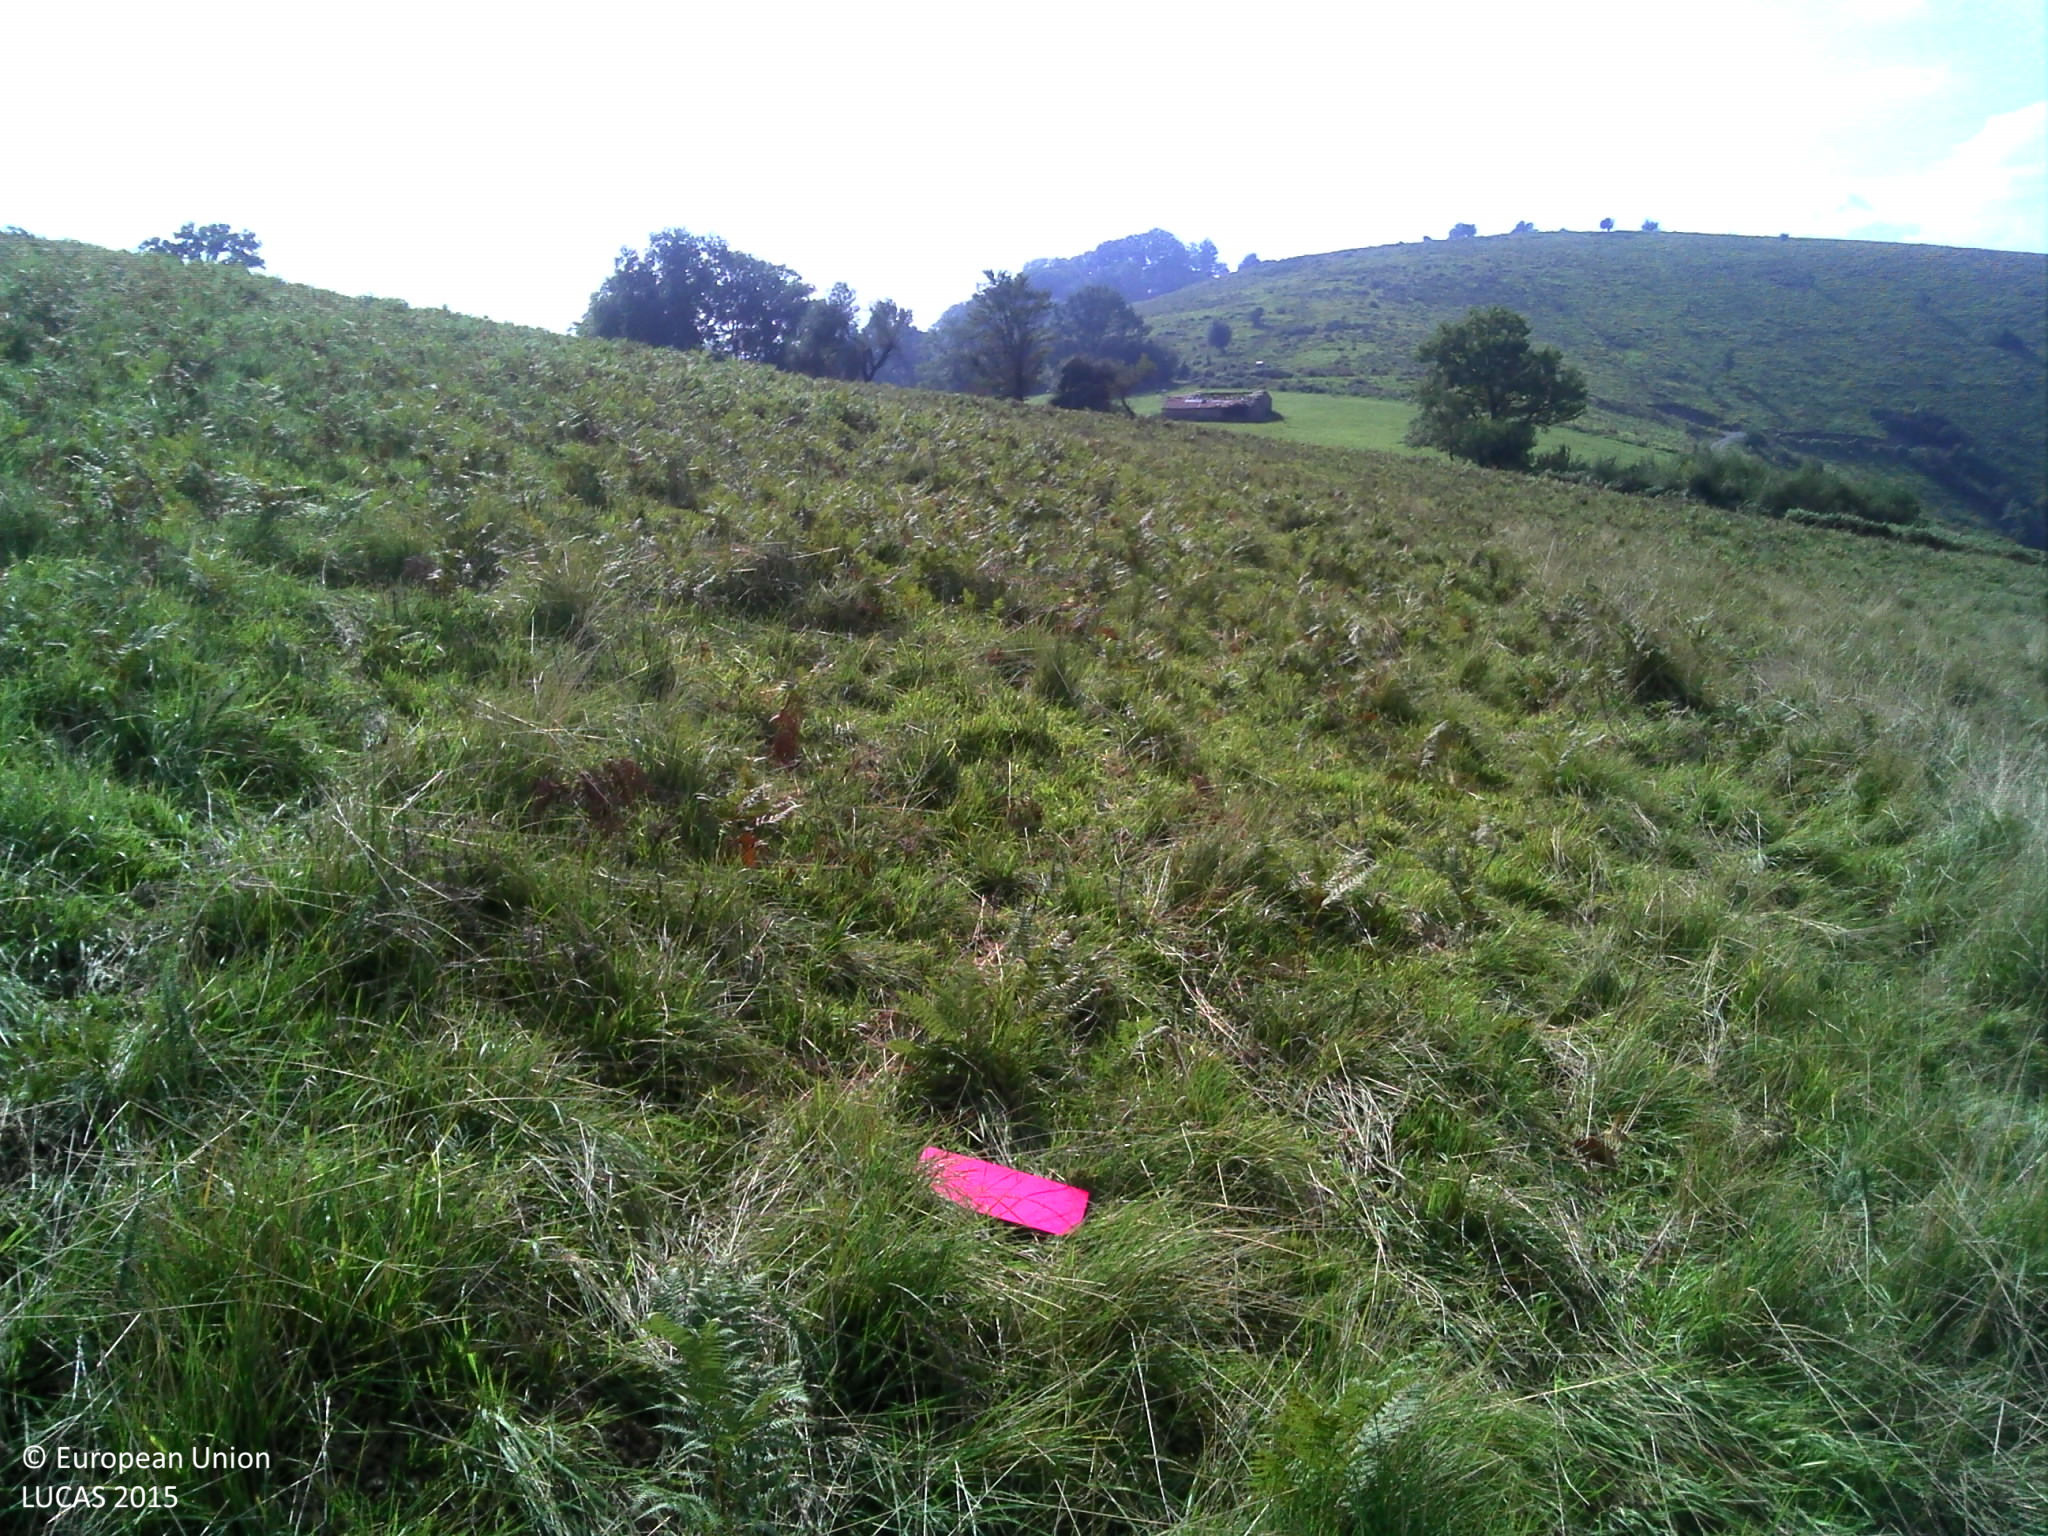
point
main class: Grassland
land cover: Grassland without tree/shrub cover
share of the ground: > 75 %
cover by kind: herbaceous plants 95 %, shrubs 5 %
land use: Agriculture (excluding fallow land and kitchen gardens)
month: September
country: FR
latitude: 43.2123
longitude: -1.0534
